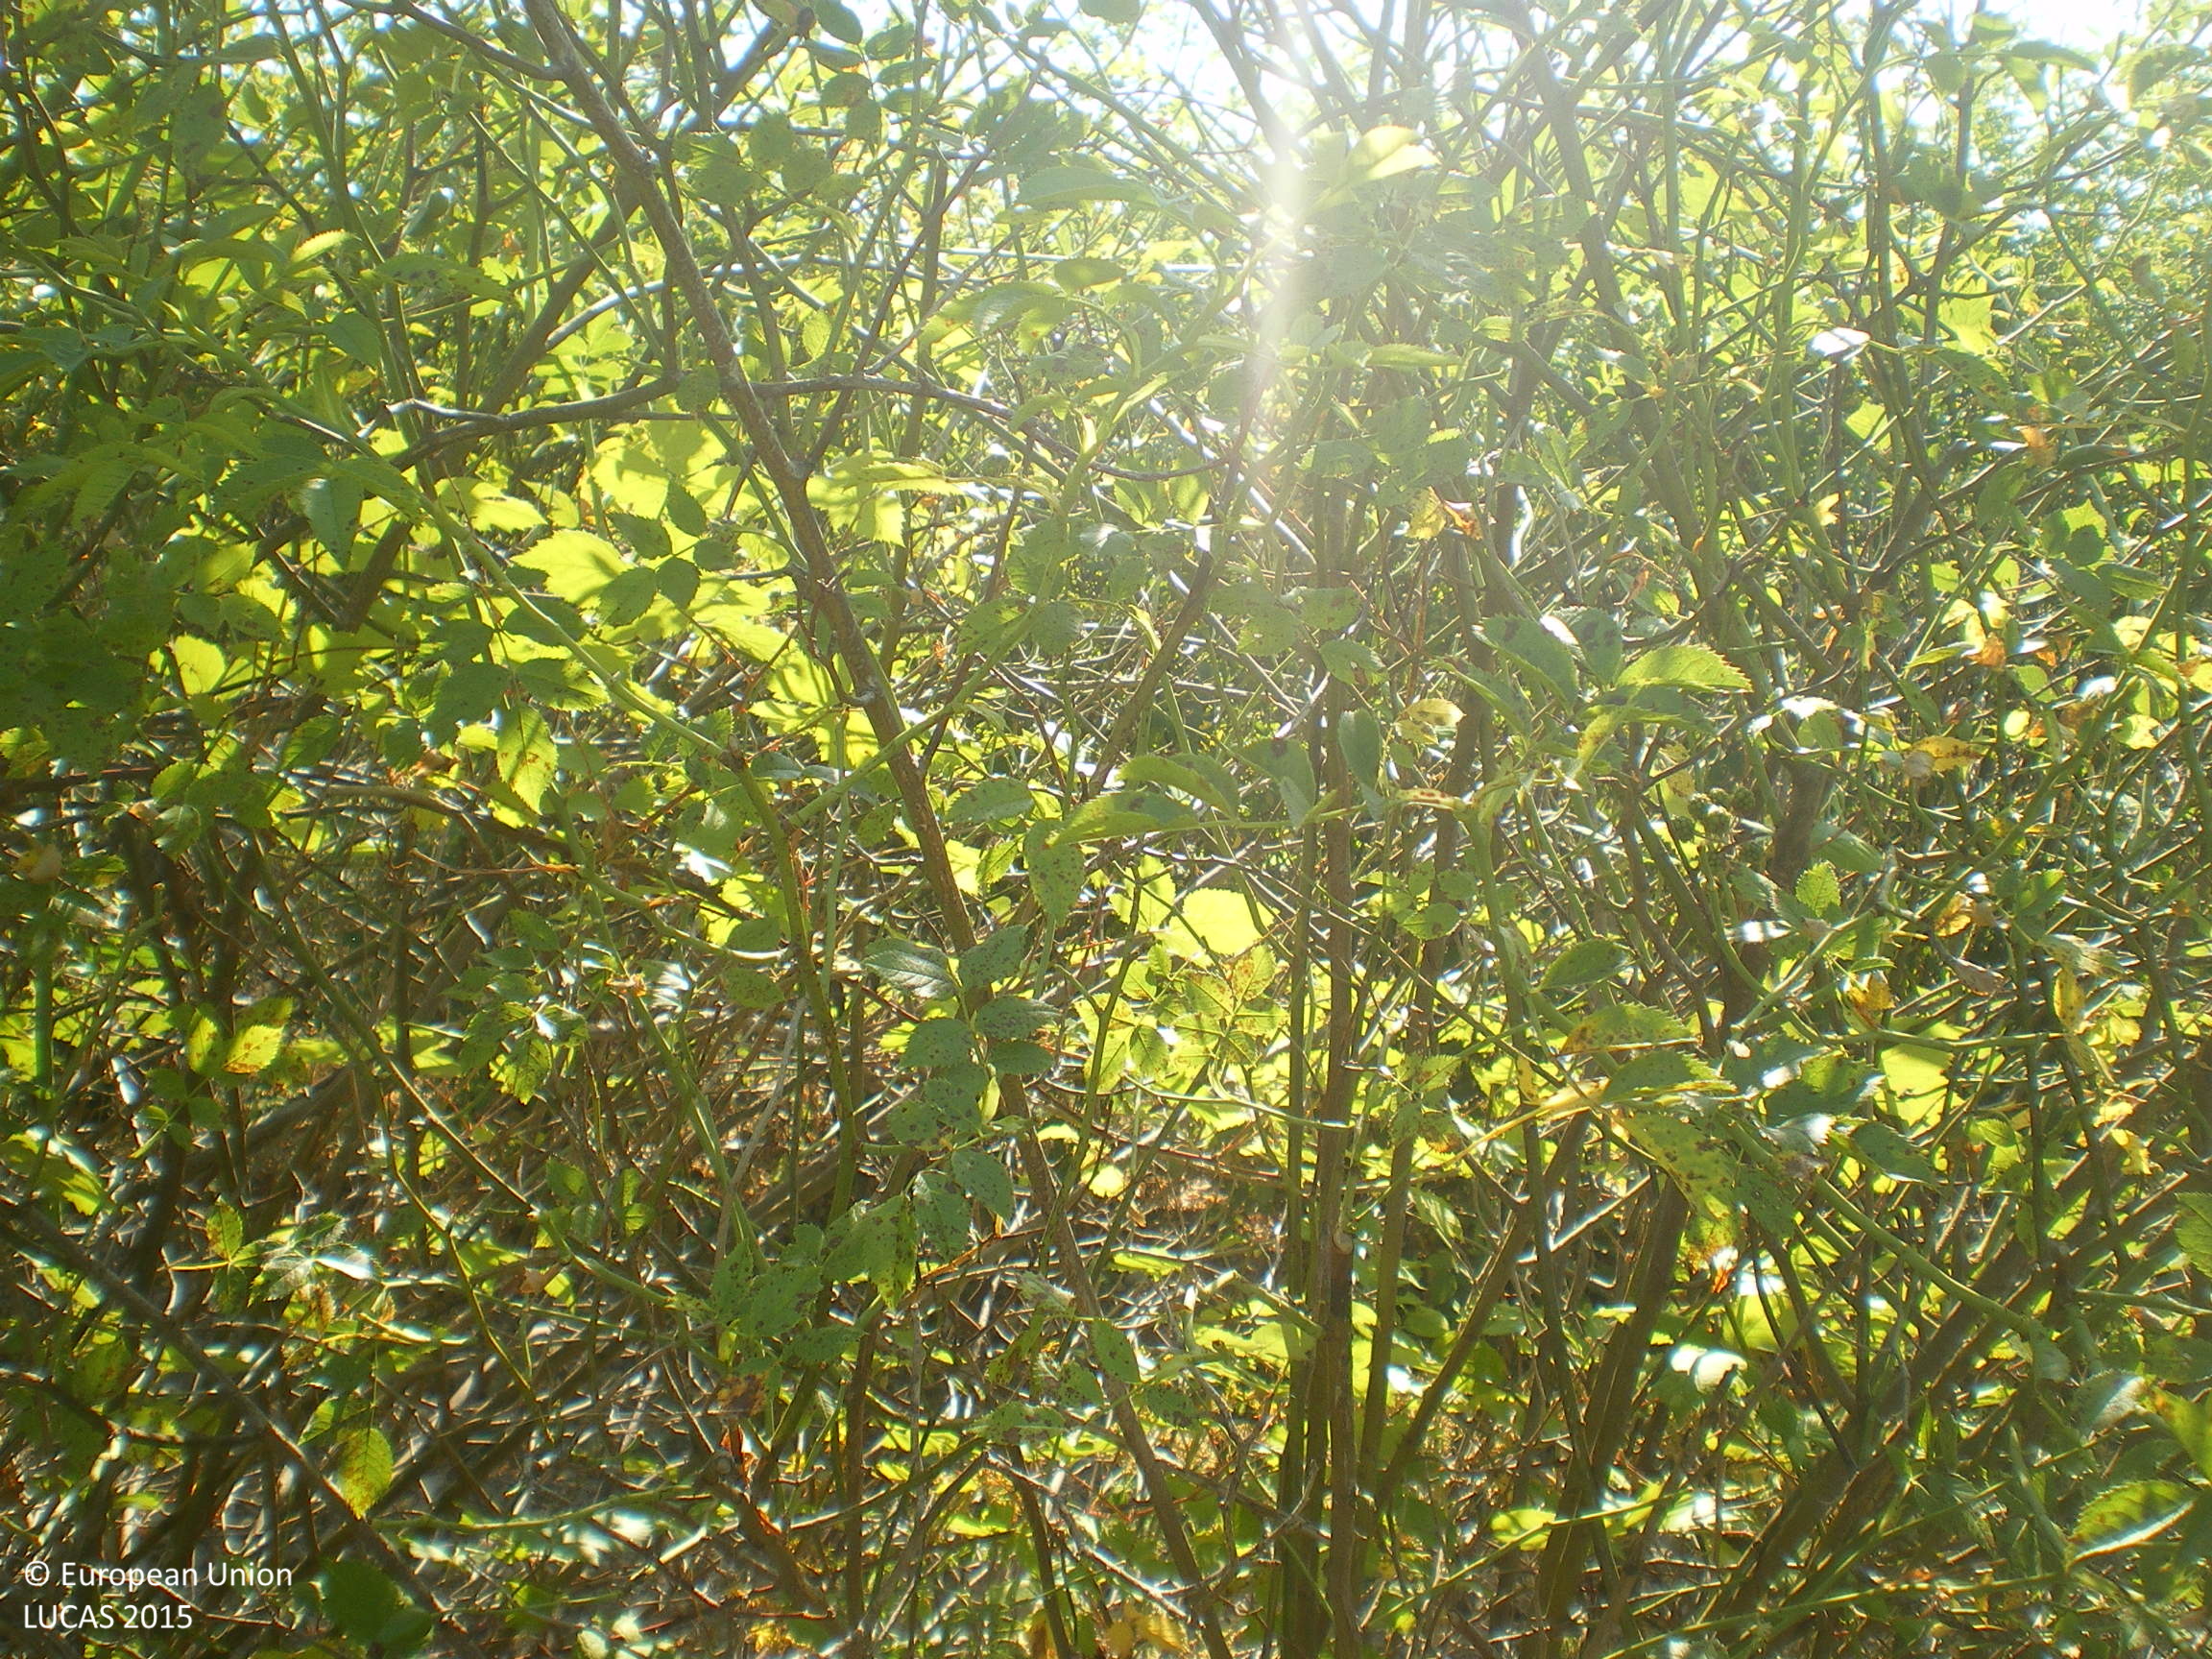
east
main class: Cropland
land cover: Permanent industrial crops
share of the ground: > 75 %
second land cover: Spontaneously vegetated surfaces
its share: < 10 %
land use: Agriculture (excluding fallow land and kitchen gardens)
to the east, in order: Permanent industrial crops; Spontaneously vegetated surfaces; Grassland with sparse tree/shrub cover; Tracks; Lines of trees; Ditches and canals; Lines of trees; Tracks; Other fibre and oleaginous crops
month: July
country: BG
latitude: 42.6472
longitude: 25.1279
